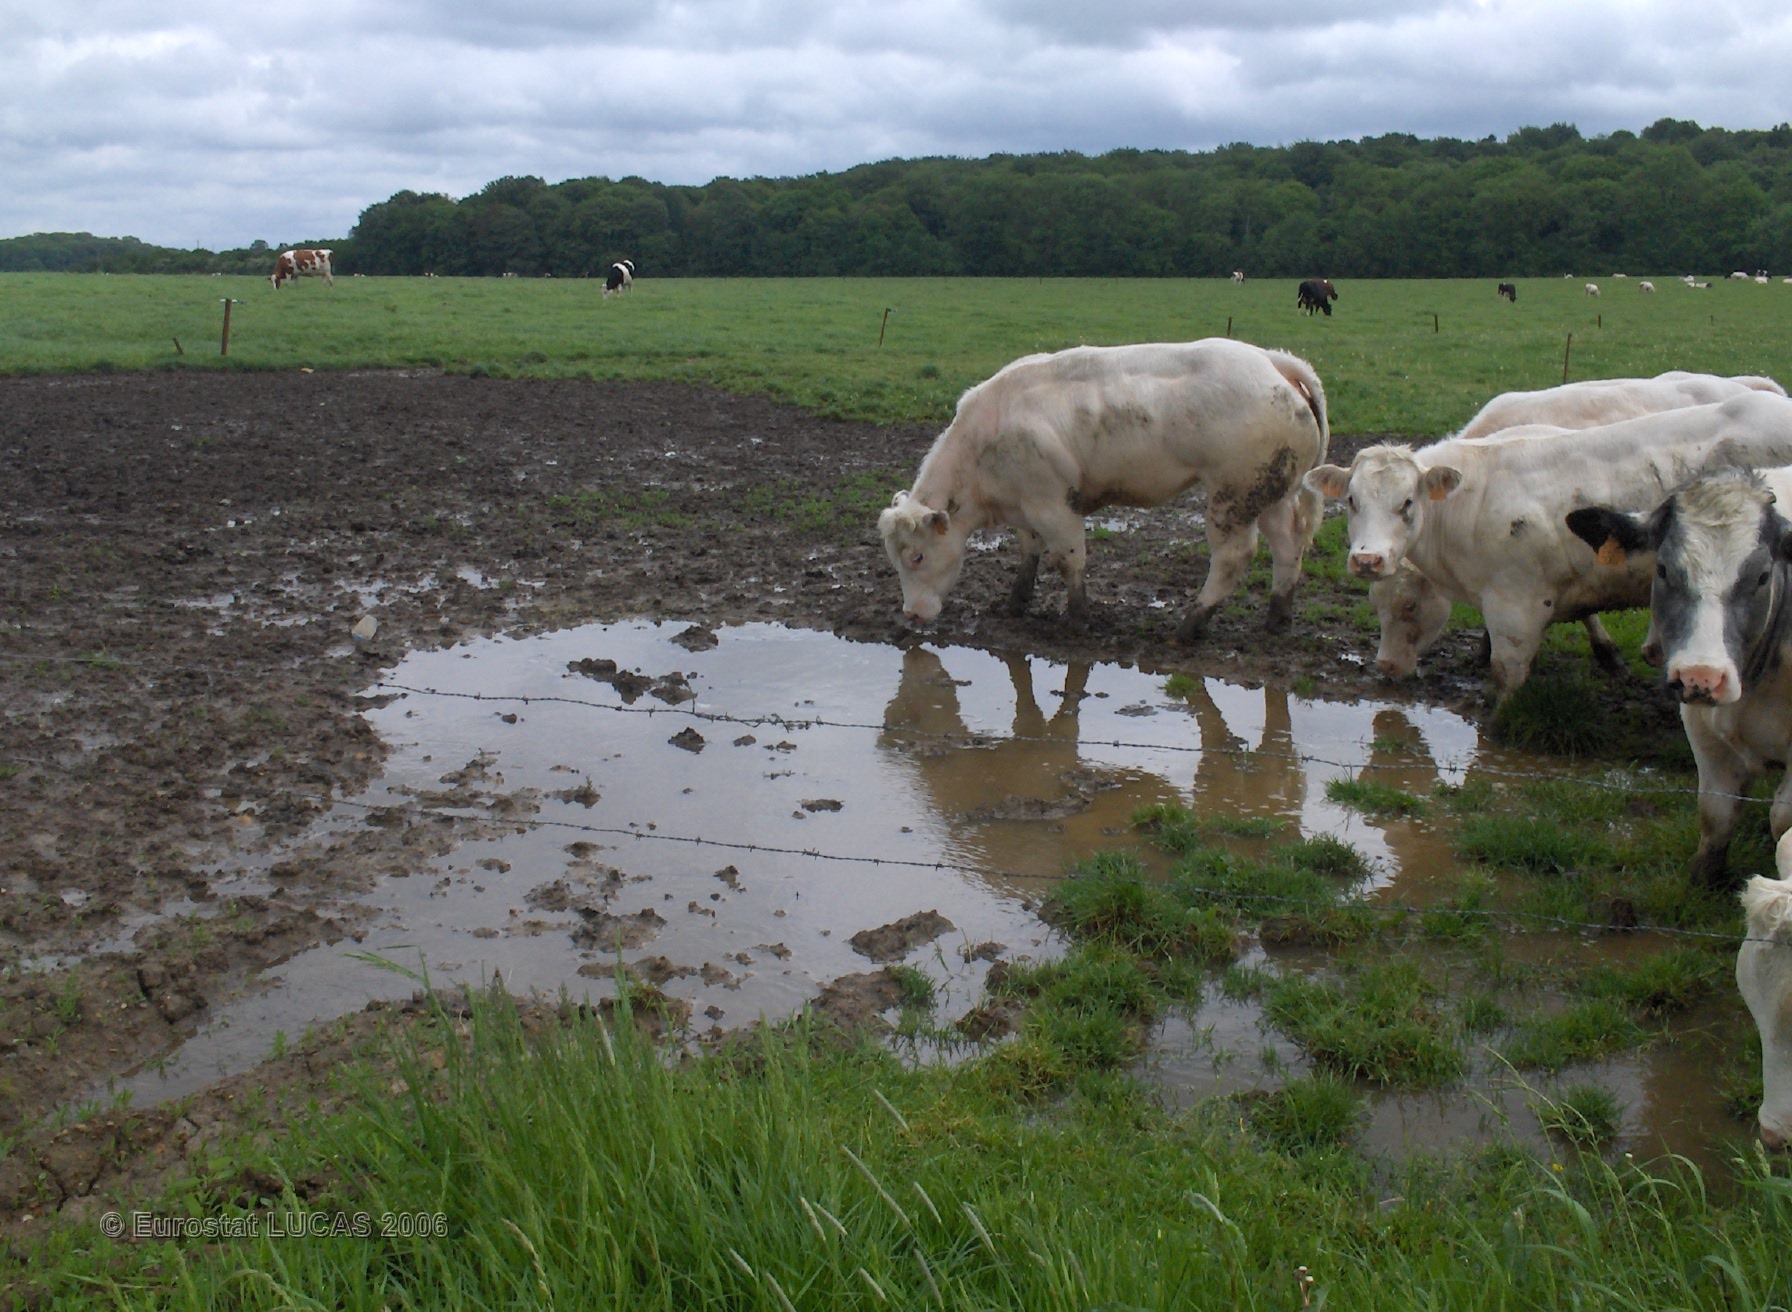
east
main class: Grassland
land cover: Grassland without tree/shrub cover
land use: Agriculture (excluding fallow land and kitchen gardens)
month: May
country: BE
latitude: 50.4098
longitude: 5.2557
